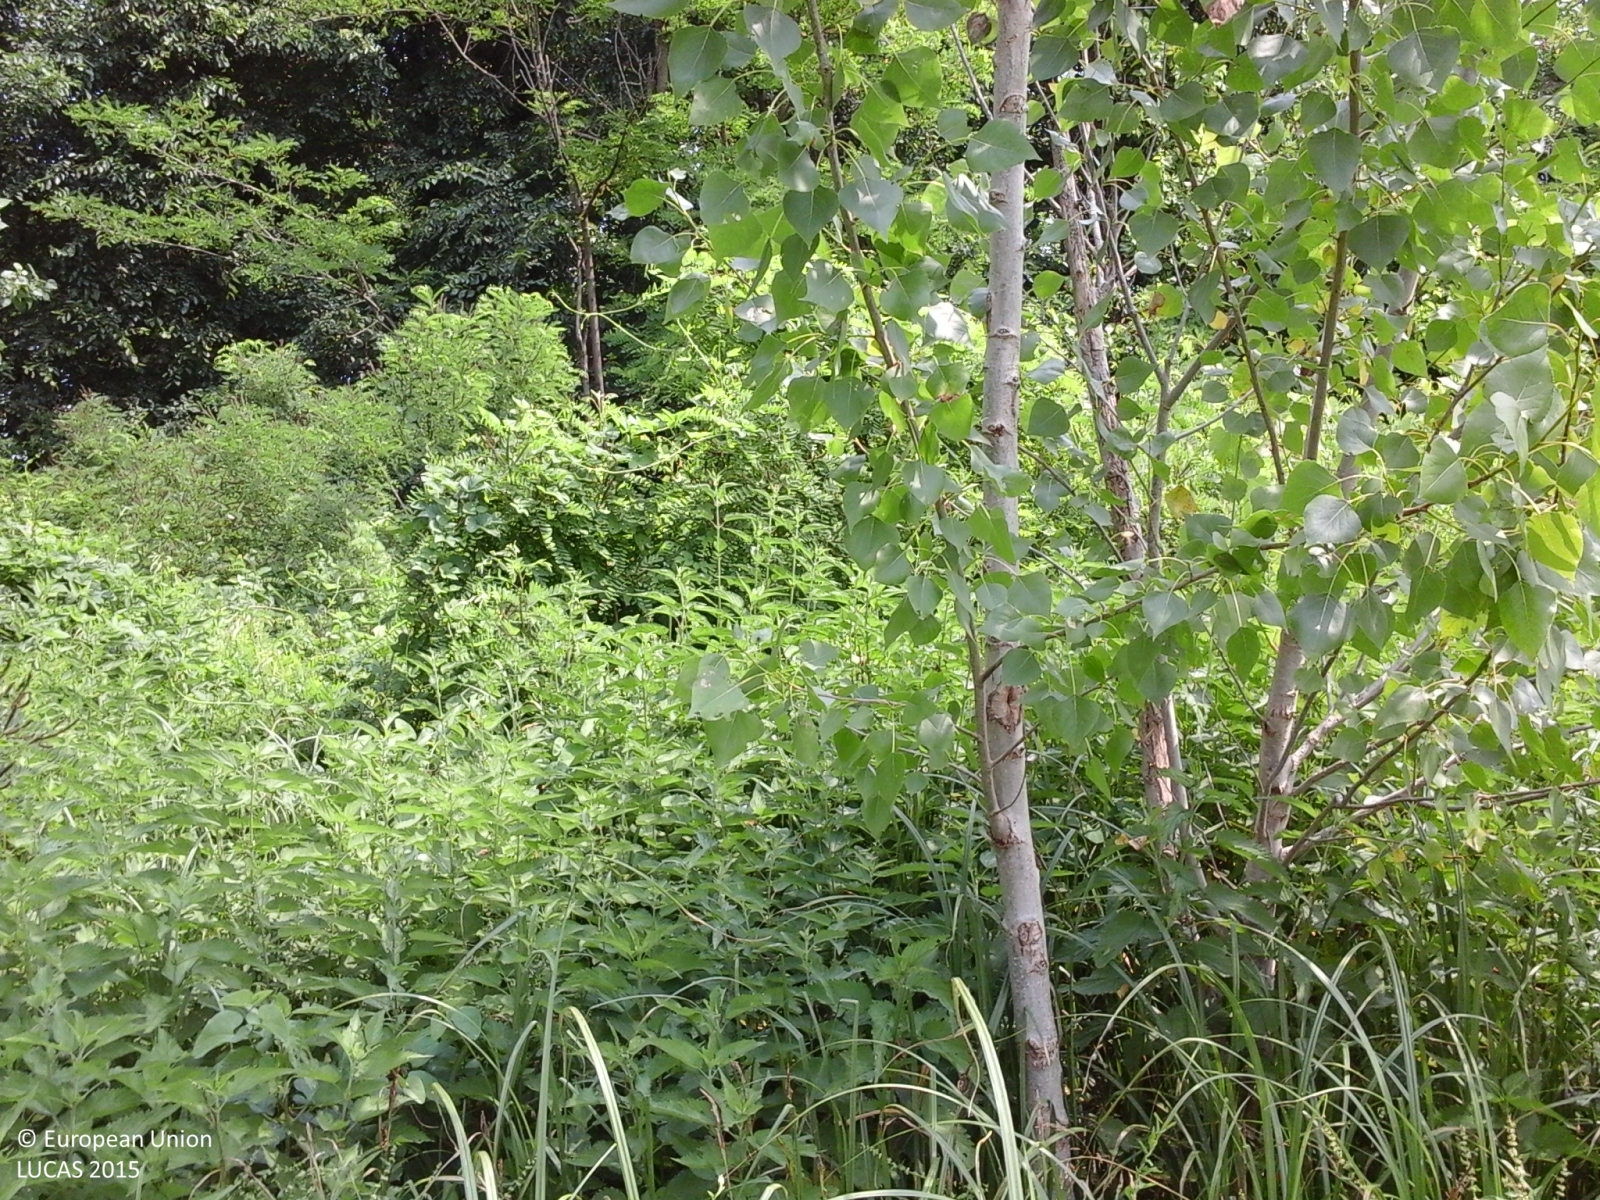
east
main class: Woodland
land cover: Broadleaved woodland
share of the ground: > 75 %
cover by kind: broadleaved forest trees 100 %
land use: Forestry
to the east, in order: Broadleaved woodland; Soya; Grassland without tree/shrub cover; Tracks; Grassland without tree/shrub cover; Maize
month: June
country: IT
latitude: 45.0538
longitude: 10.0634
